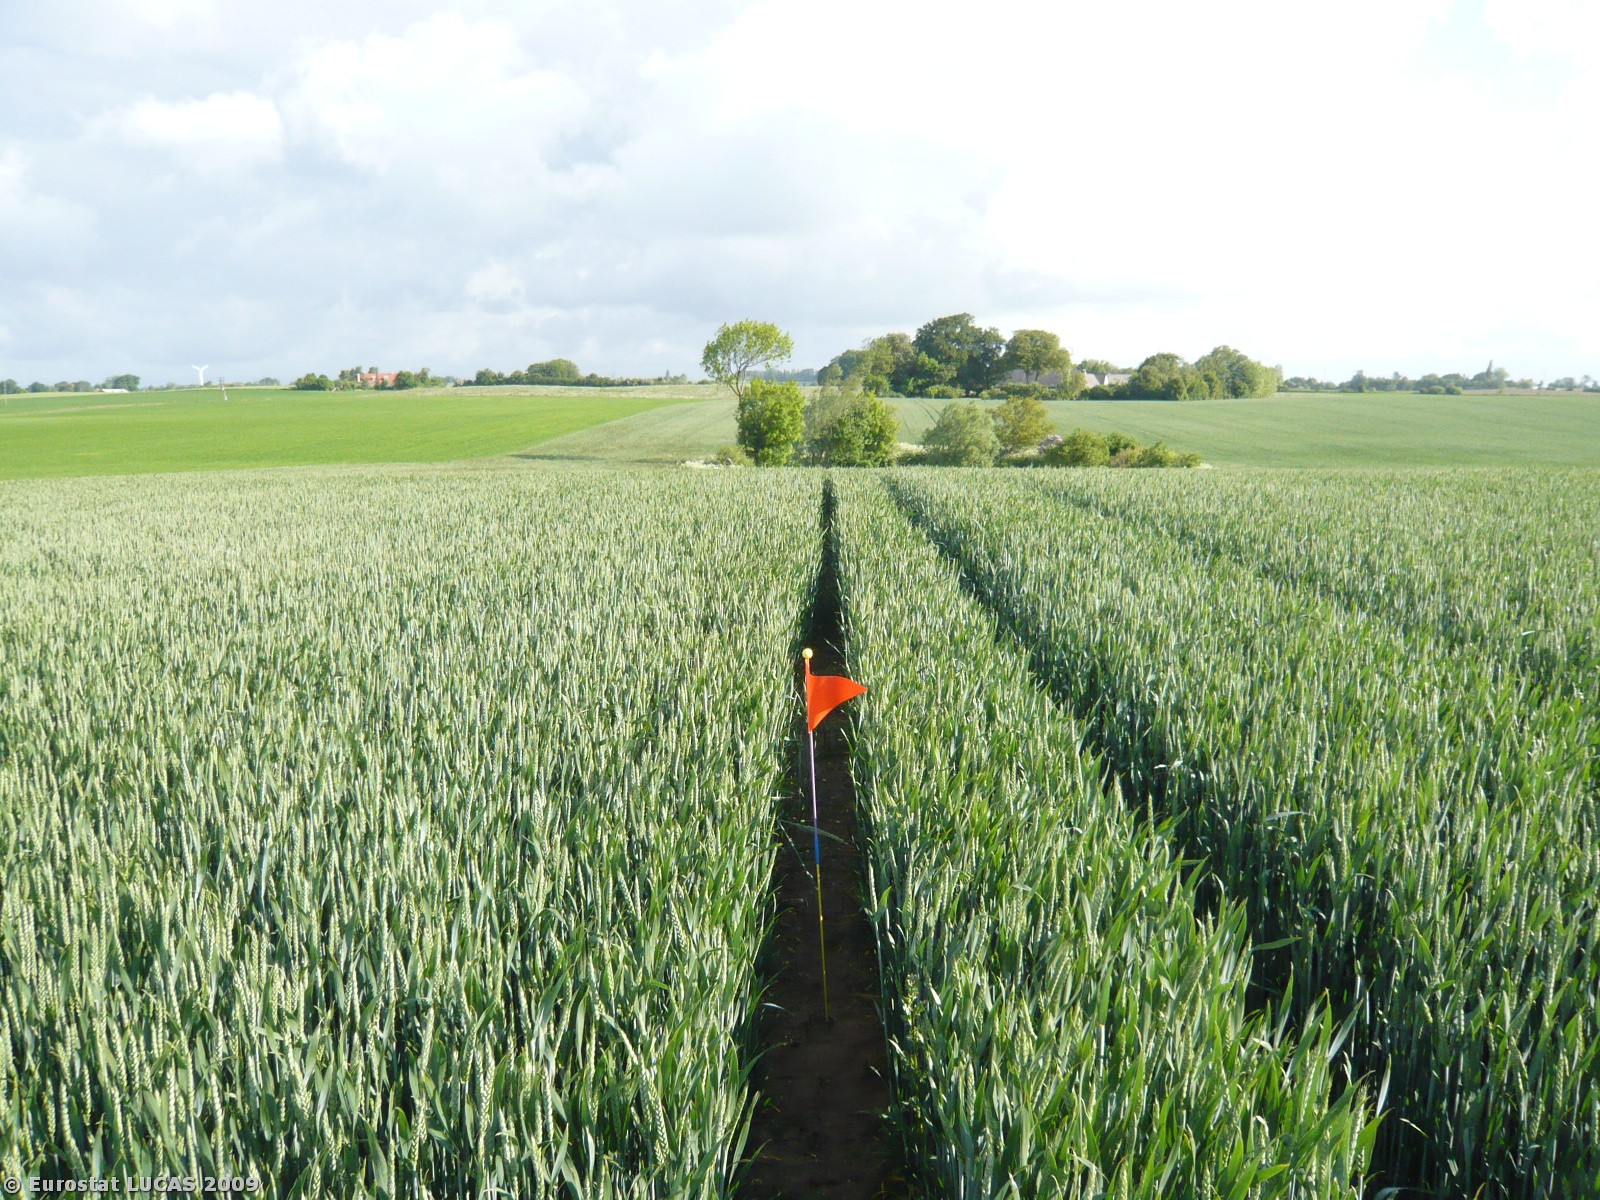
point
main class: Cropland
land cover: Common wheat
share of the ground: > 75 %
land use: Agriculture (excluding fallow land and kitchen gardens)
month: June
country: DK
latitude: 54.9451
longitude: 12.2623
